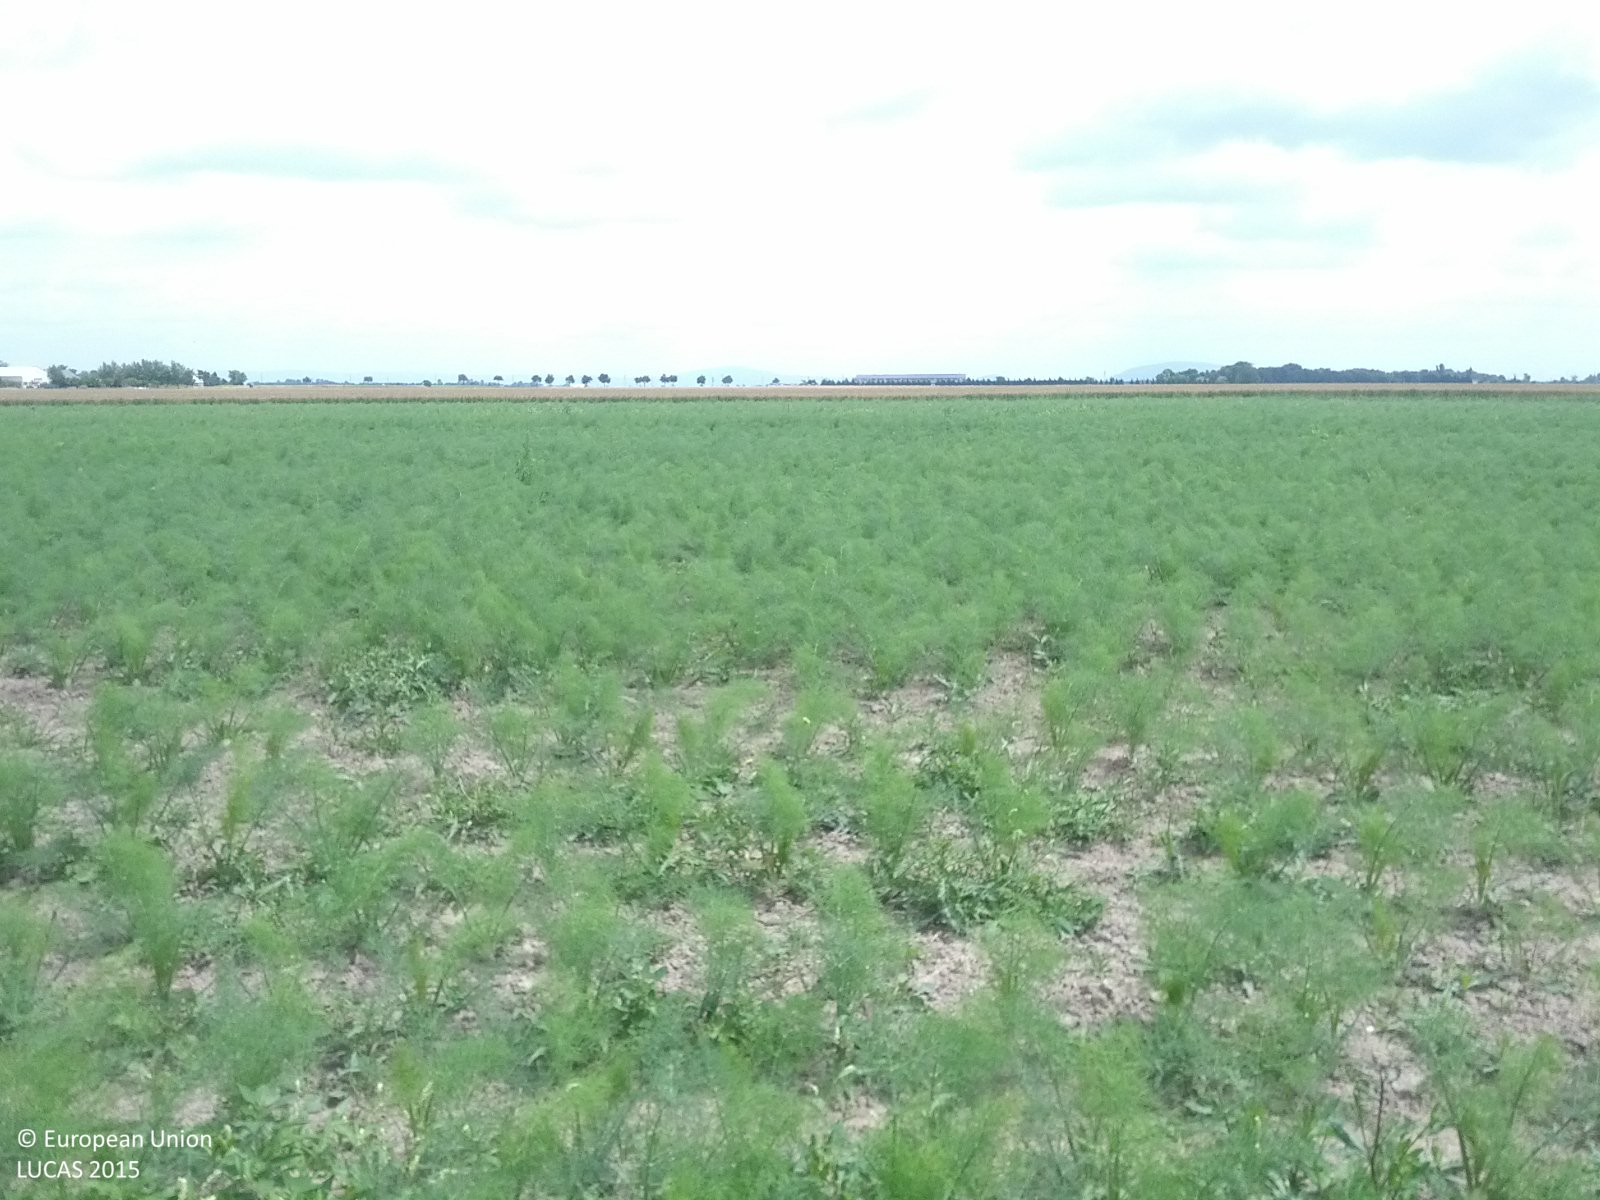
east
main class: Cropland
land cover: Other non-permanent industrial crops
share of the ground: > 75 %
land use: Agriculture (excluding fallow land and kitchen gardens)
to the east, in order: Other non-permanent industrial crops; Potatoes; Other fresh vegetables; Potatoes; Durum wheat
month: June
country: AT
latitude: 48.1860
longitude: 16.6373
